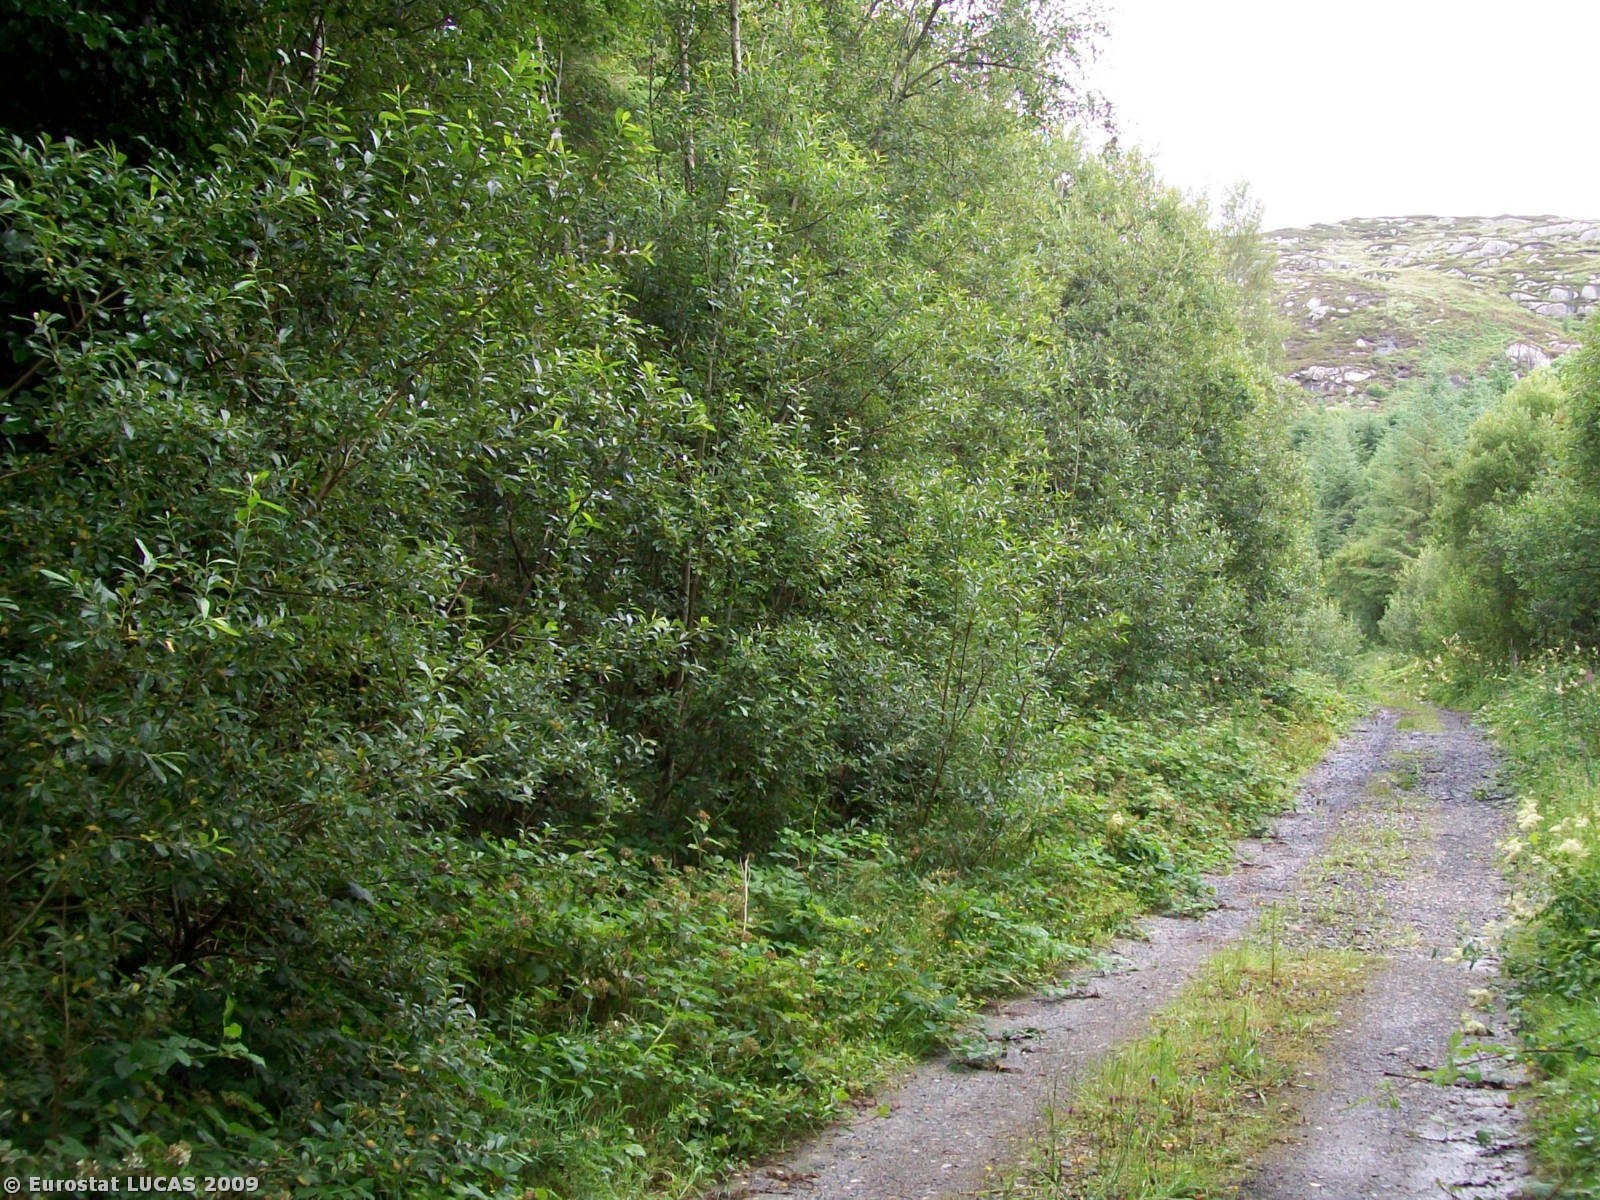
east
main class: Grassland
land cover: Grassland without tree/shrub cover
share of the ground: > 75 %
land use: Agriculture (excluding fallow land and kitchen gardens)
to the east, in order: Grassland without tree/shrub cover; Mixed woodland; Broadleaved woodland
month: July
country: IE
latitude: 53.9705
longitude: -9.1041
